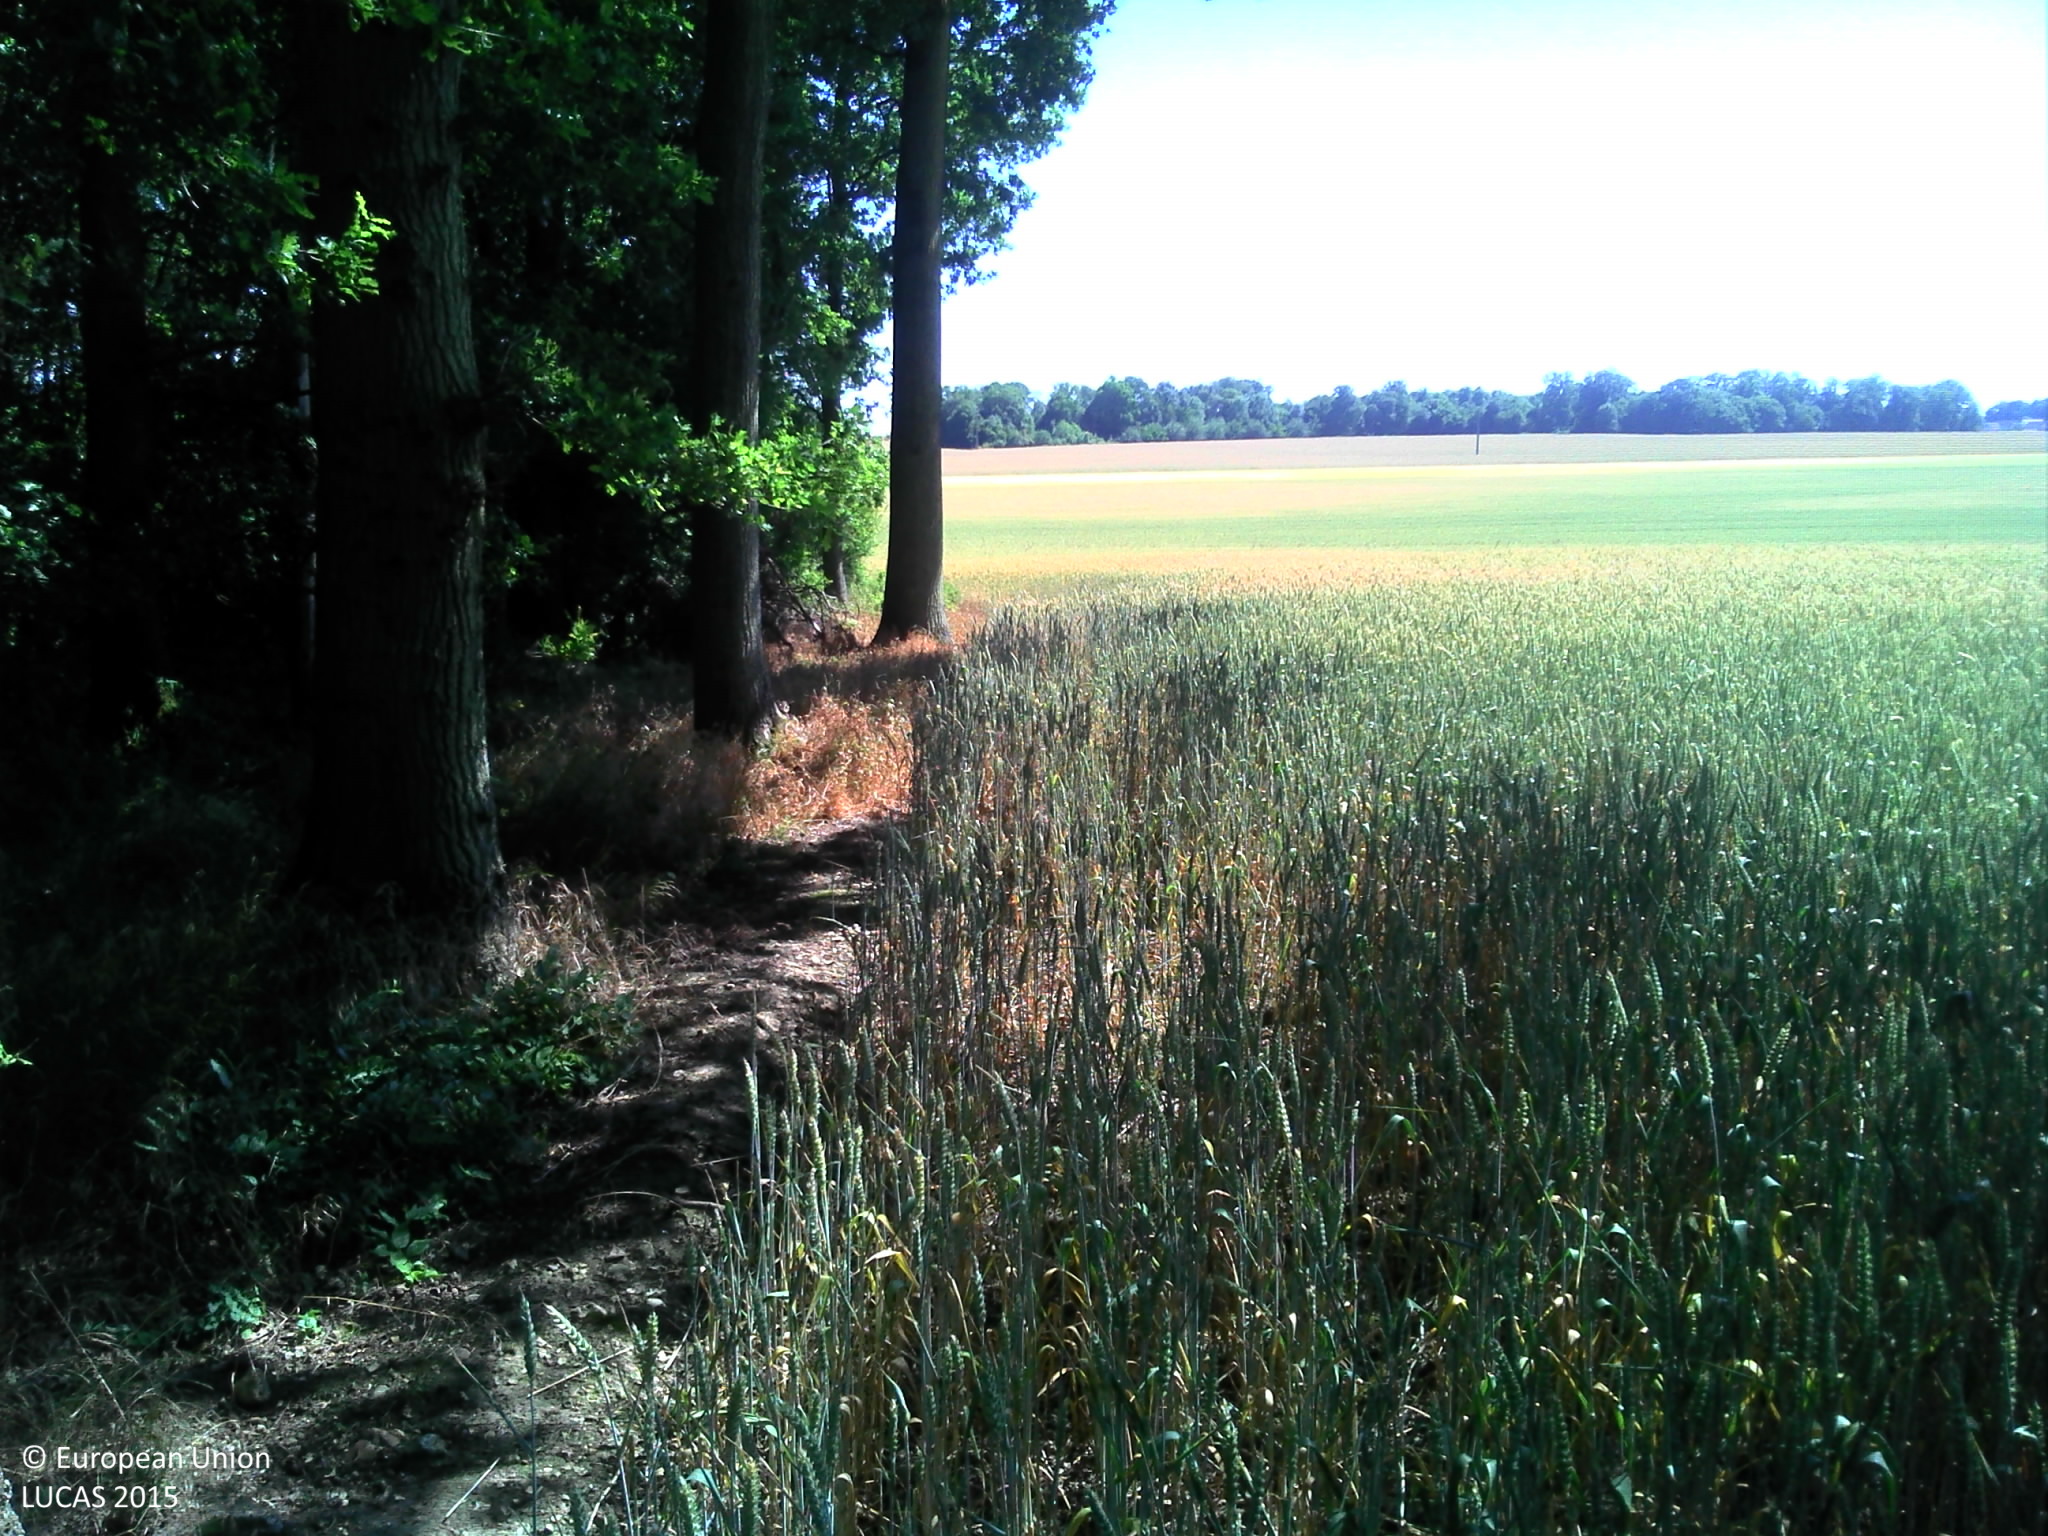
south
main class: Woodland
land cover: Broadleaved woodland
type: mesophytic deciduous forest
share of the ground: > 75 %
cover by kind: broadleaved forest trees 80 %, herbaceous plants 10 %, consolidated bare surface 10 %
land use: Forestry
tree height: > 5 m
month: June
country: FR
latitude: 48.9925
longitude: 1.1922
